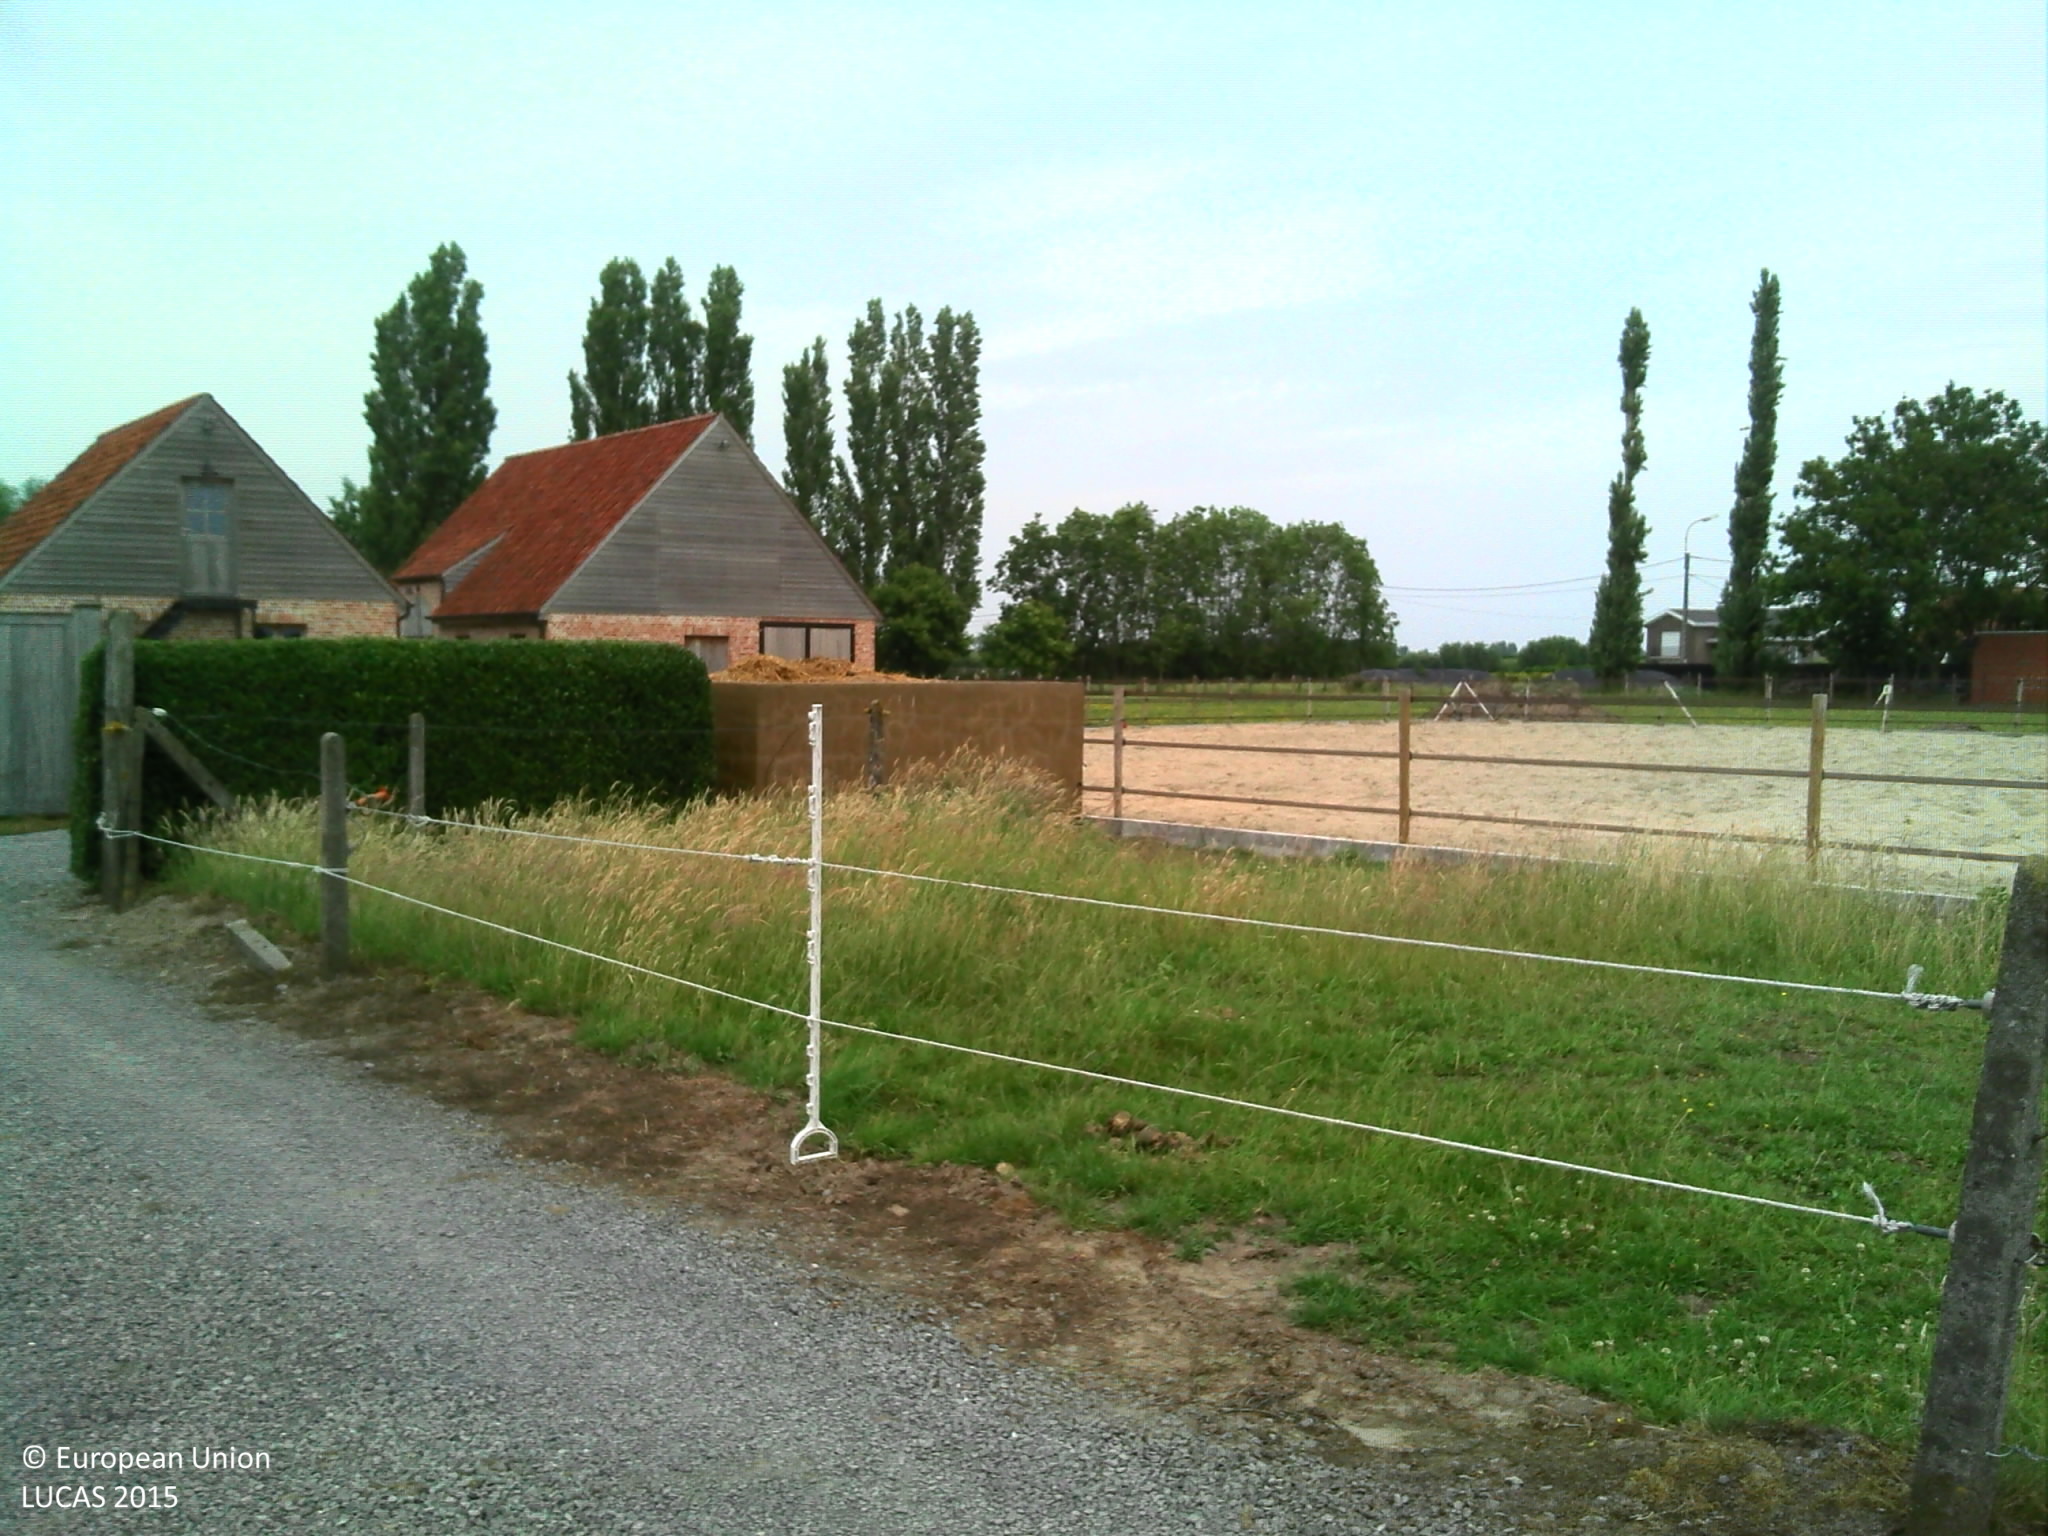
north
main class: Grassland
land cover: Grassland without tree/shrub cover
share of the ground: > 75 %
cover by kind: herbaceous plants 100 %
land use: Agriculture (excluding fallow land and kitchen gardens)
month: June
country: BE
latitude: 50.9509
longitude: 3.4297
